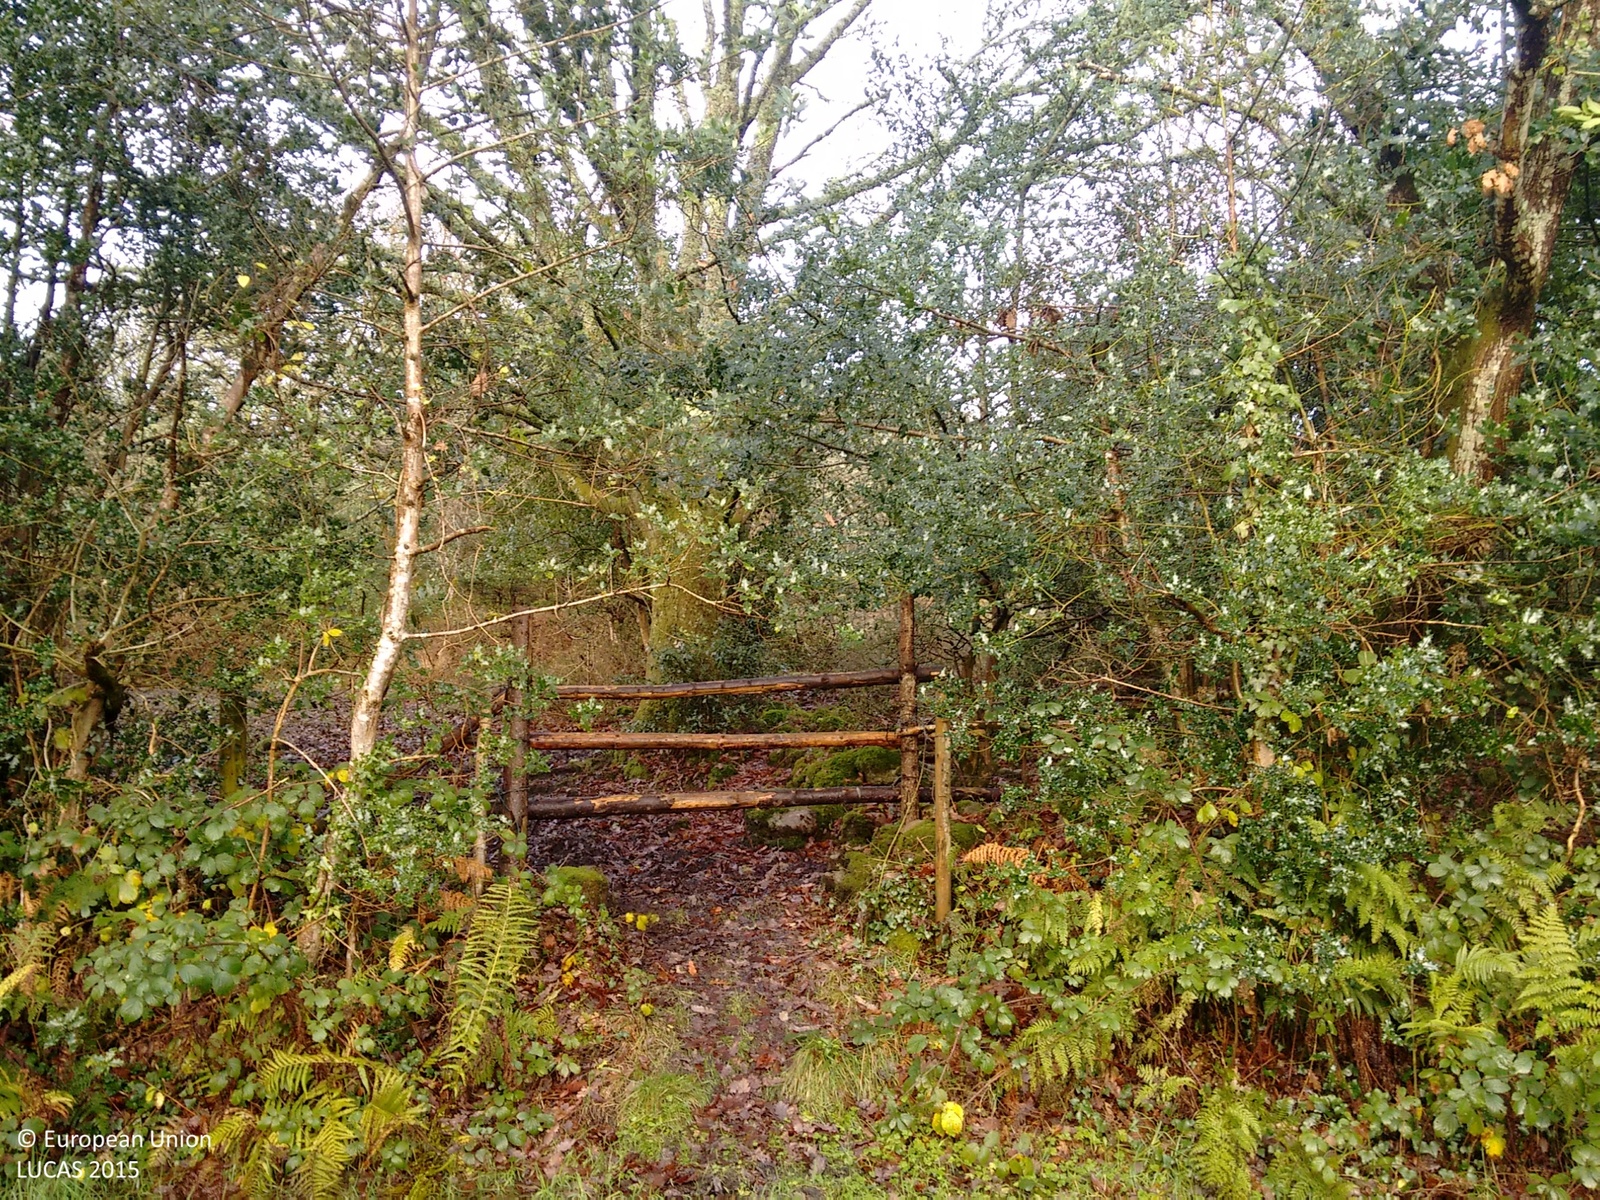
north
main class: Woodland
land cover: Spruce dominated coniferous woodland
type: exotic forest
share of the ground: > 75 %
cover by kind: coniferous forest trees 100 %
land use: Forestry
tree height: > 5 m
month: November
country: IE
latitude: 54.2732
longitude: -8.2254
